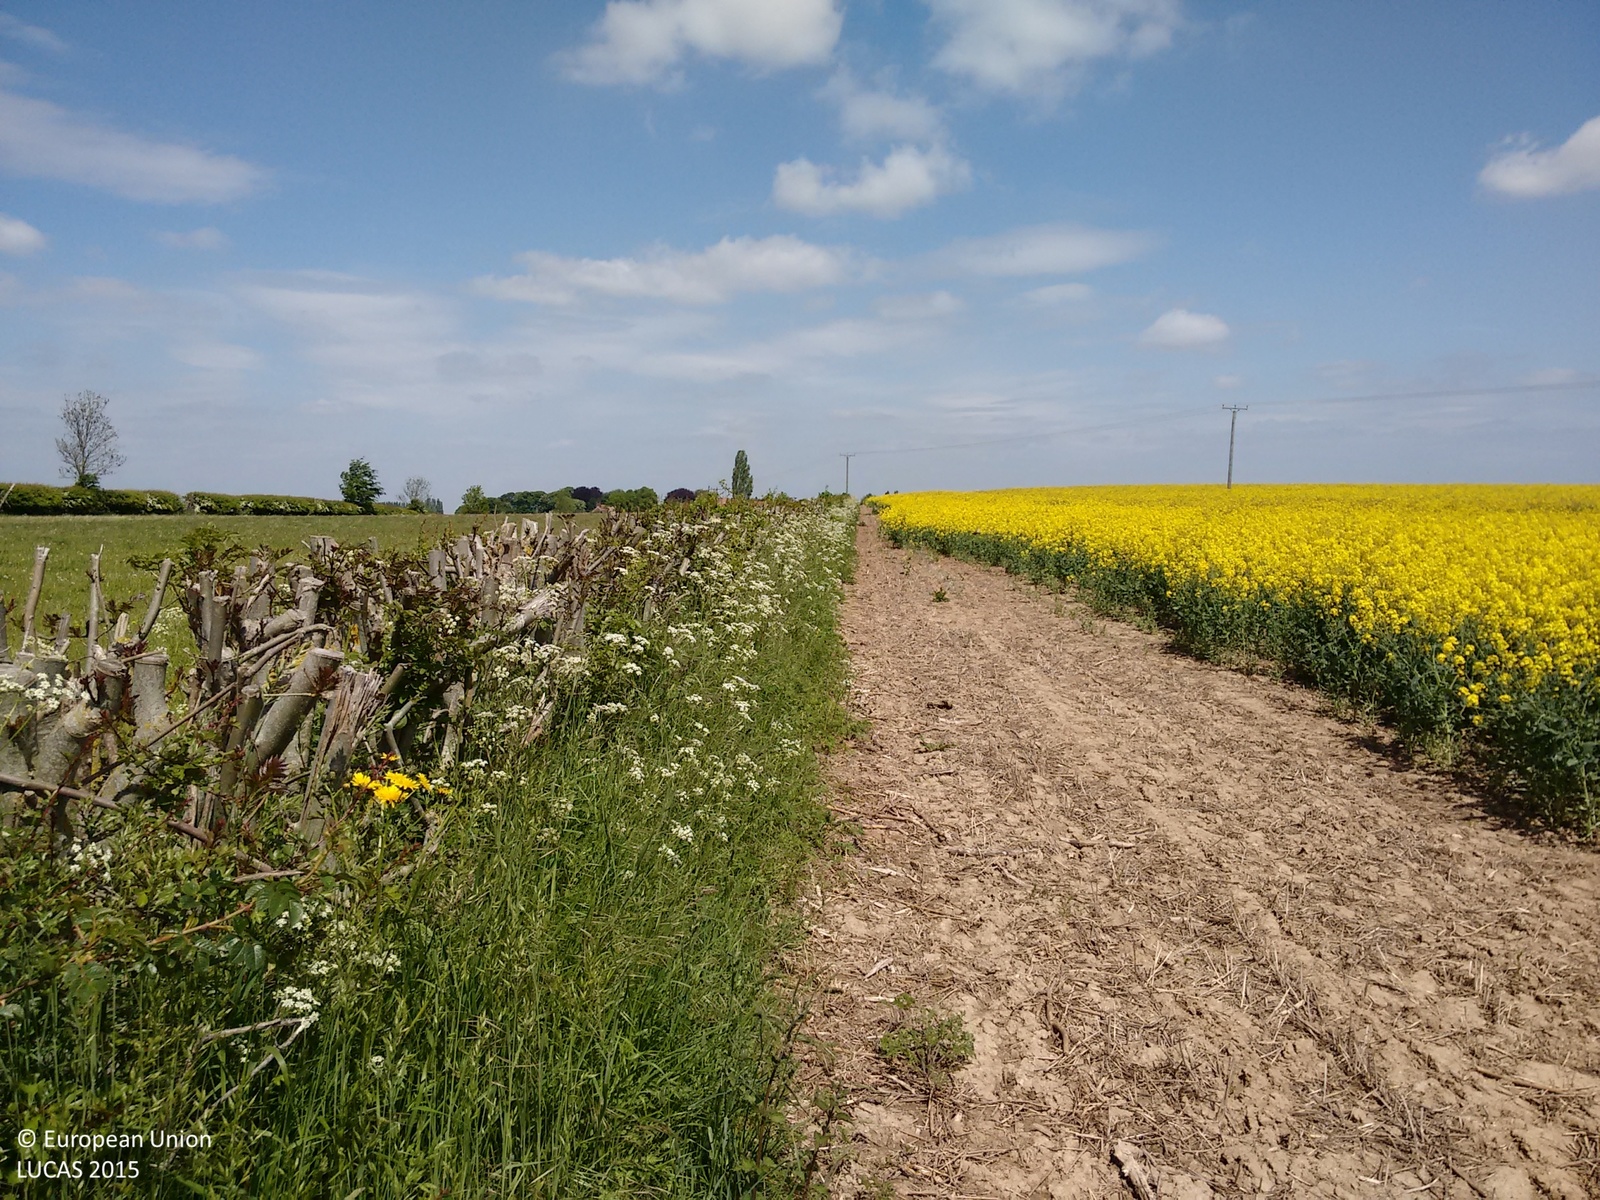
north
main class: Grassland
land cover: Grassland without tree/shrub cover
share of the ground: > 75 %
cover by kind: herbaceous plants 100 %
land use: Agriculture (excluding fallow land and kitchen gardens)
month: May
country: GB
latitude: 53.5141
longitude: -0.8236
